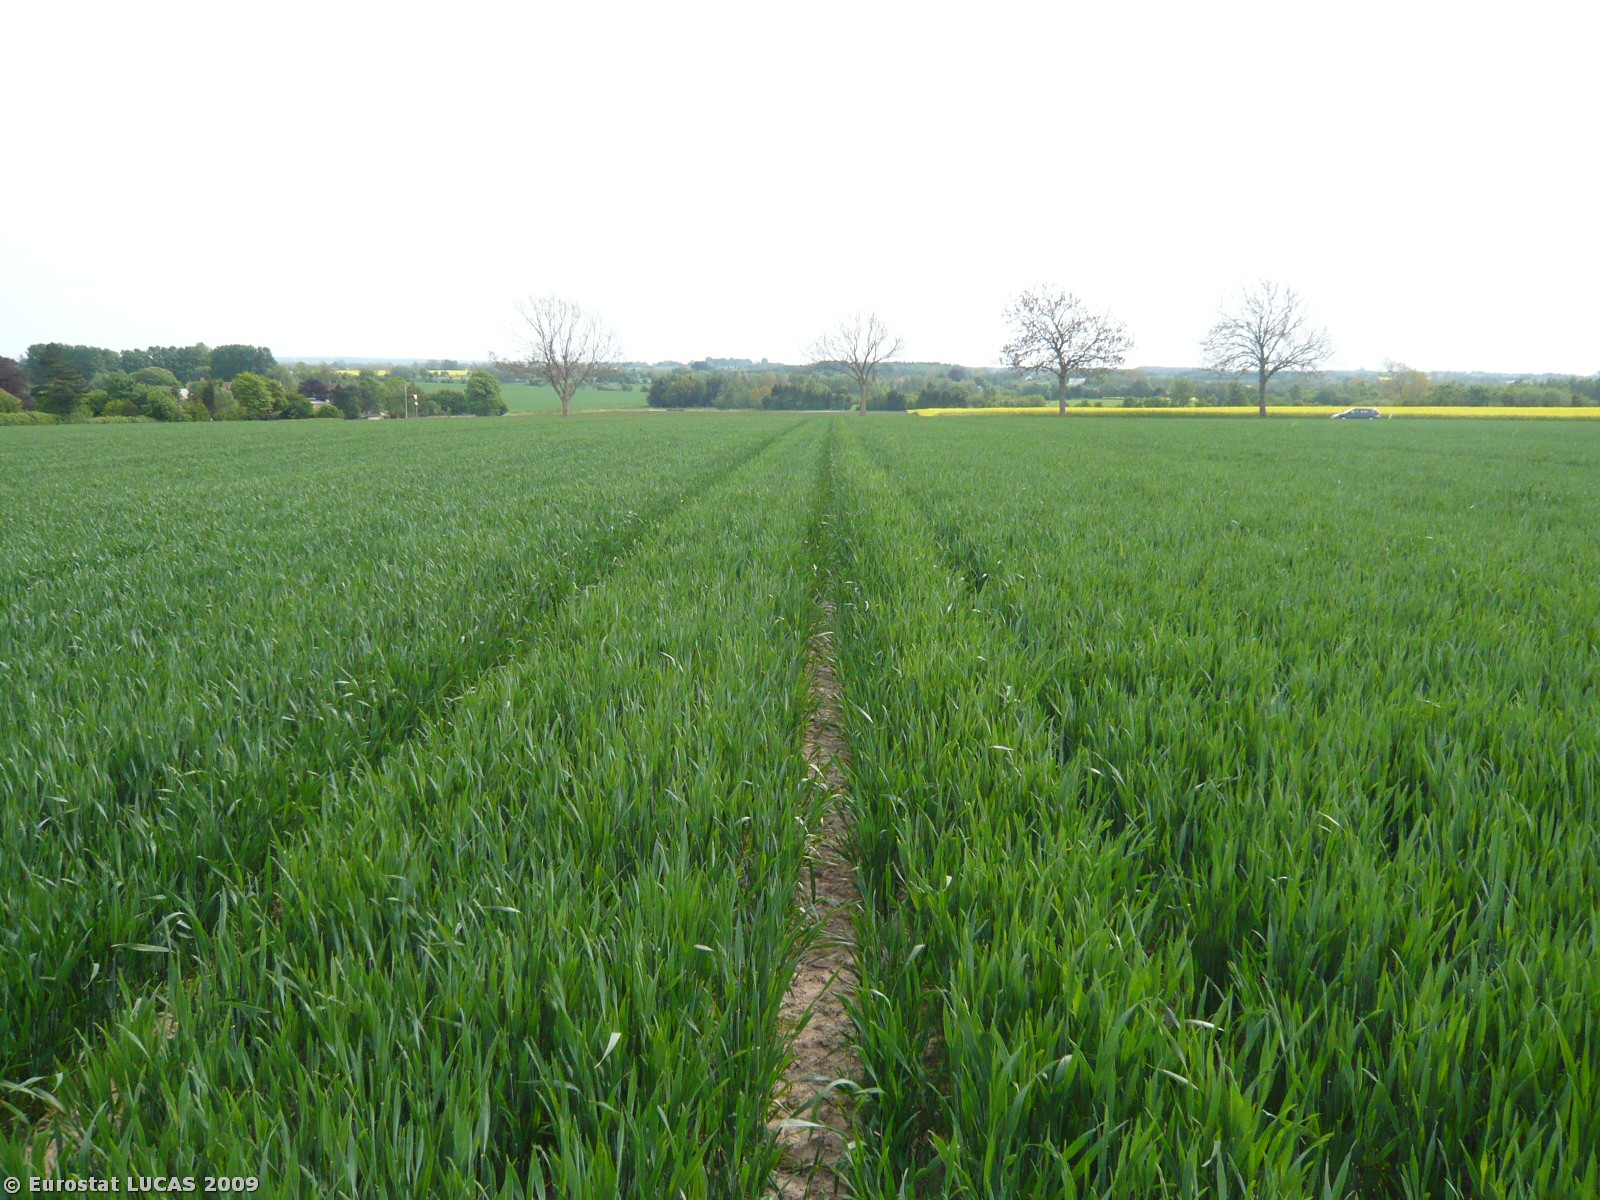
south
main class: Cropland
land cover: Common wheat
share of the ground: > 75 %
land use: Agriculture (excluding fallow land and kitchen gardens)
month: May
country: DK
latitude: 55.3834
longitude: 11.8453
